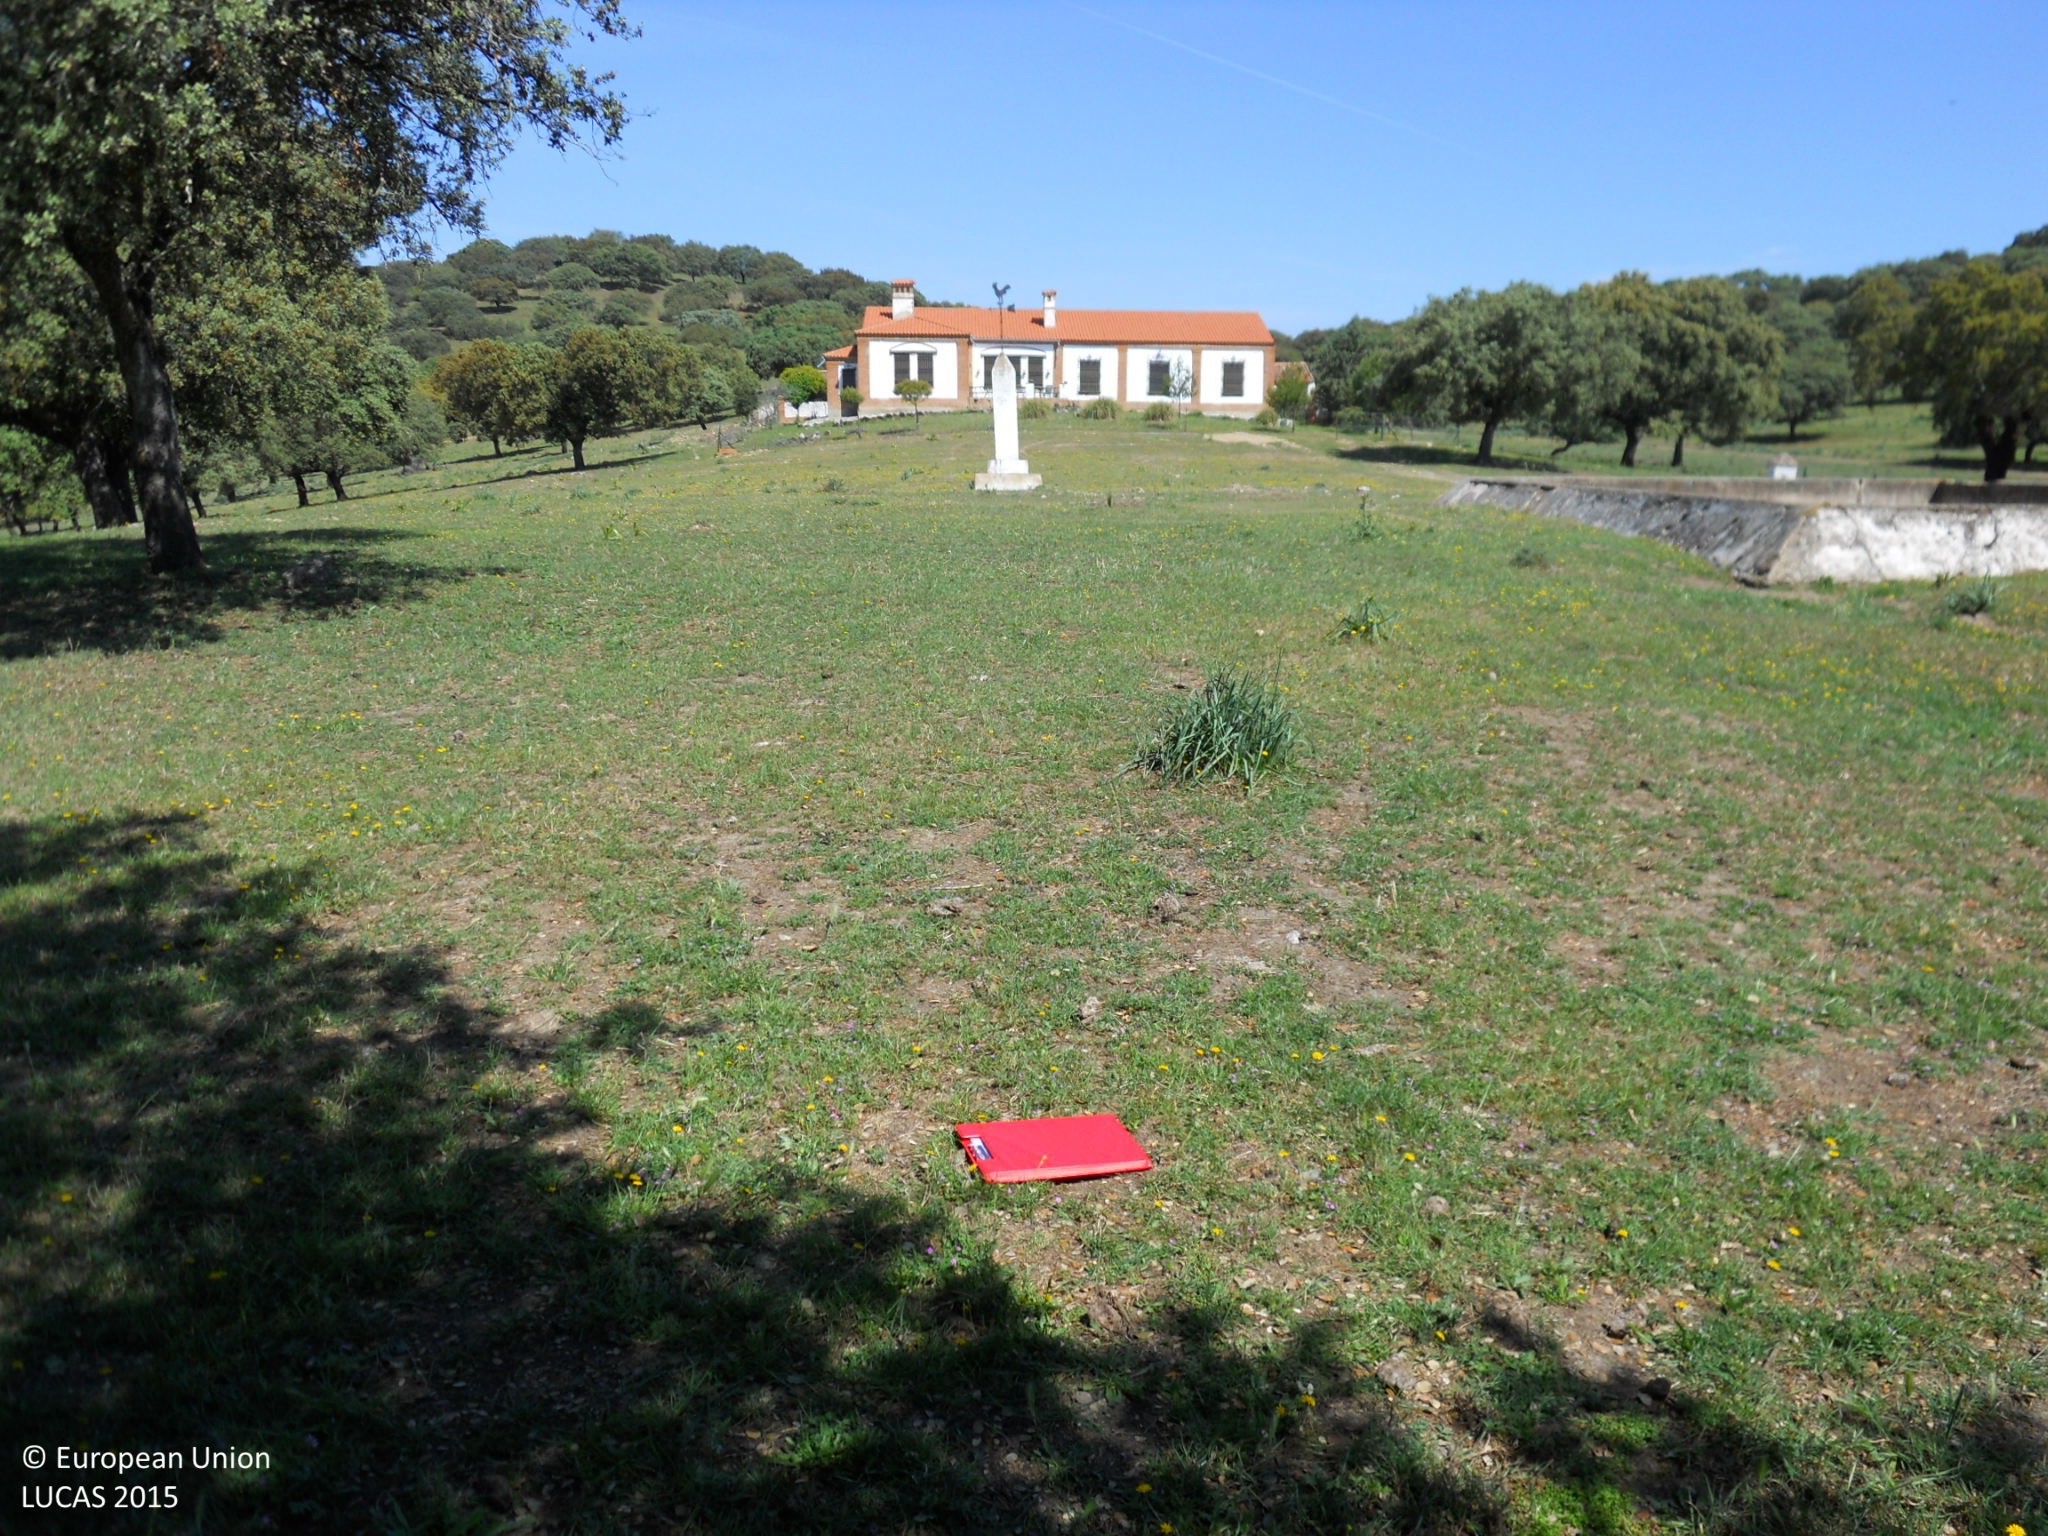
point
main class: Woodland
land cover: Broadleaved woodland
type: broadleaved evergreen forest
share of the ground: > 75 %
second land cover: Grassland without tree/shrub cover
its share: > 75 %
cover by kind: broadleaved forest trees 90 %, herbaceous plants 10 %
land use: Forestry
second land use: Agriculture (excluding fallow land and kitchen gardens)
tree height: > 5 m
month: April
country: ES
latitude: 39.2192
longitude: -6.7619
